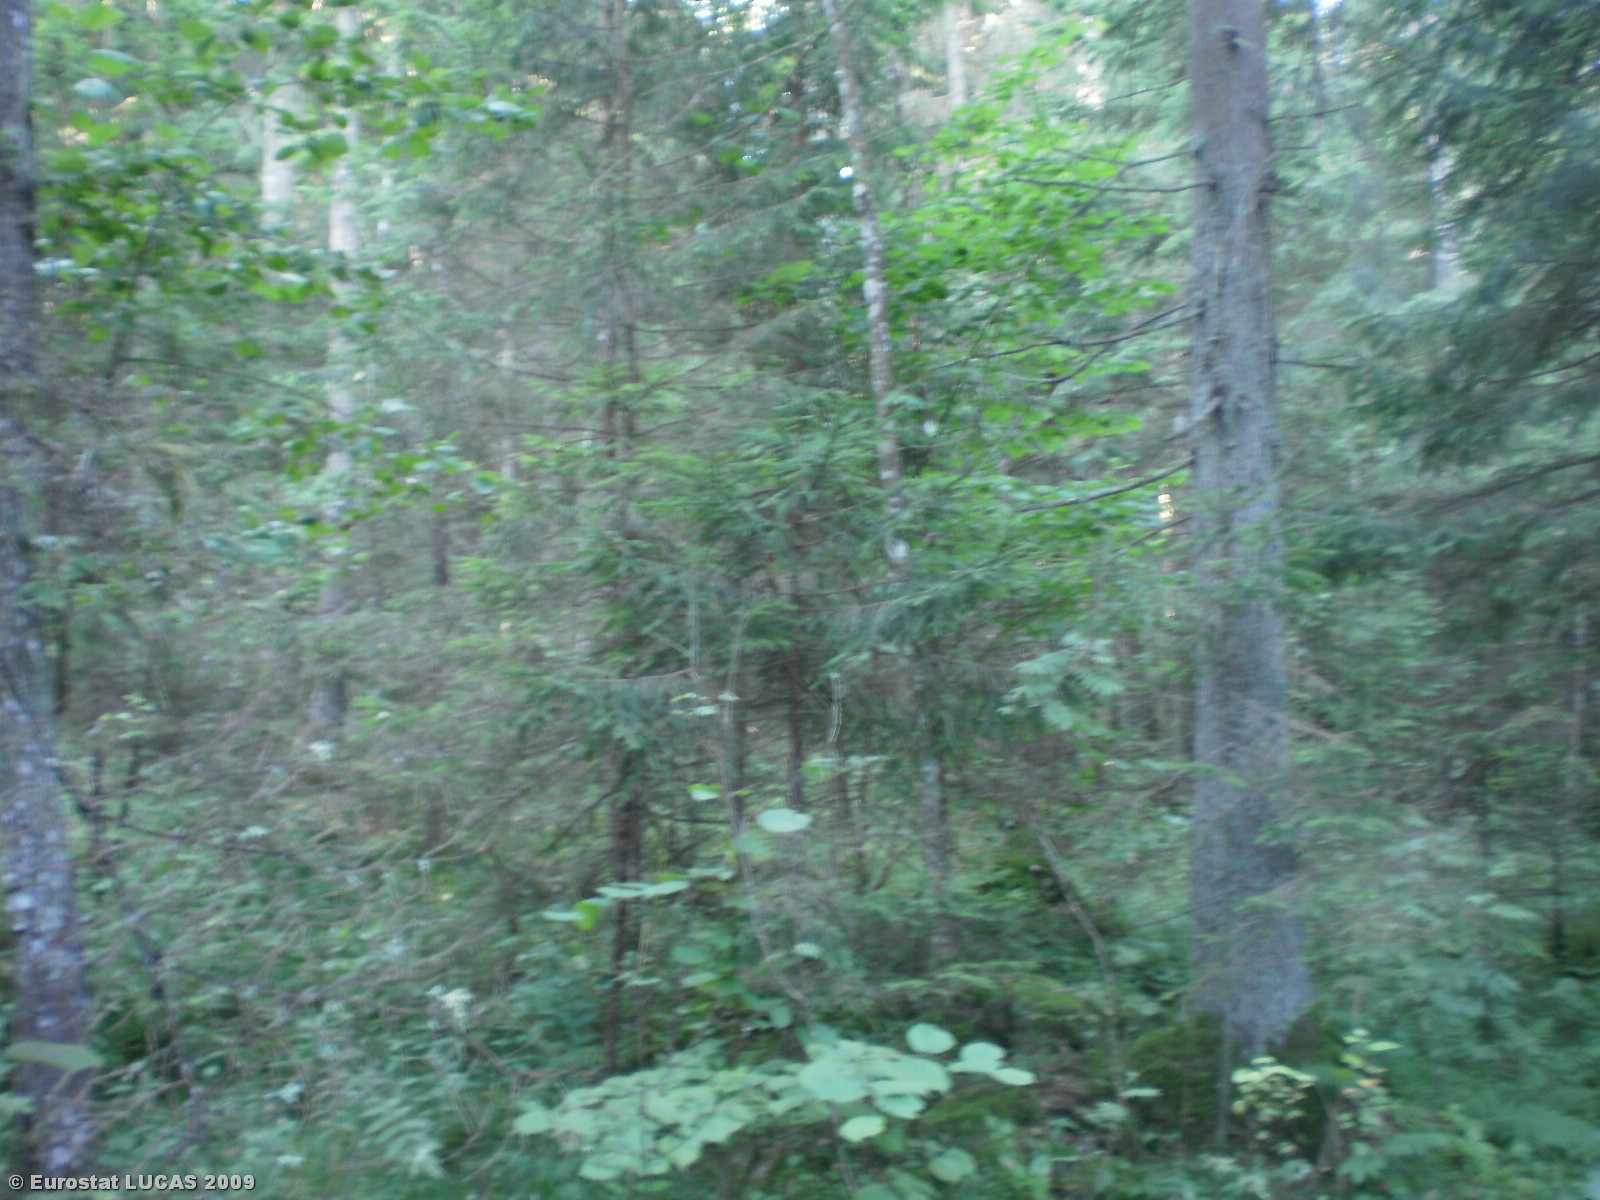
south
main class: Woodland
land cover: Mixed woodland
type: hemiboreal forest and nemoral coniferous forest and mixed broadleaved-coniferous forest
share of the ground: > 75 %
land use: Forestry
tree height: > 5 m
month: August
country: LT
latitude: 55.7079
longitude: 24.7954
